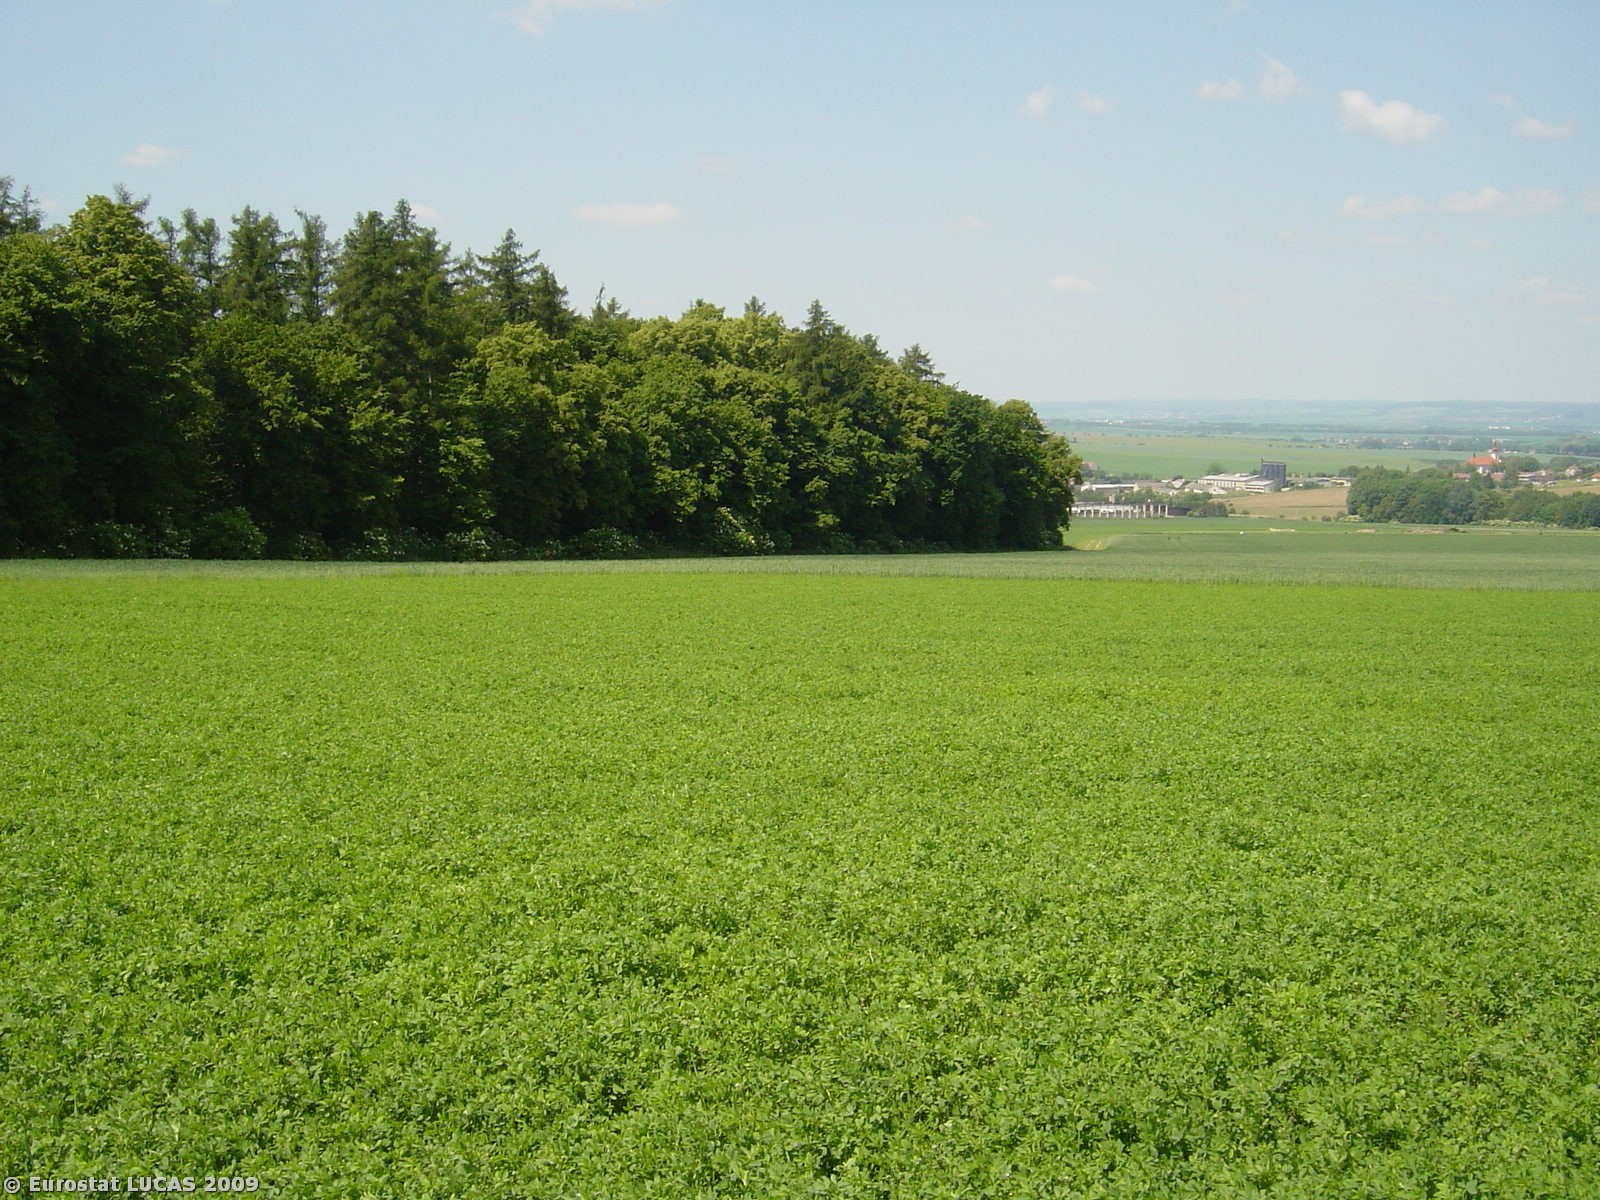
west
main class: Cropland
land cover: Lucerne
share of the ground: > 75 %
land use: Agriculture (excluding fallow land and kitchen gardens)
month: May
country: CZ
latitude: 49.2670
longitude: 17.2528
